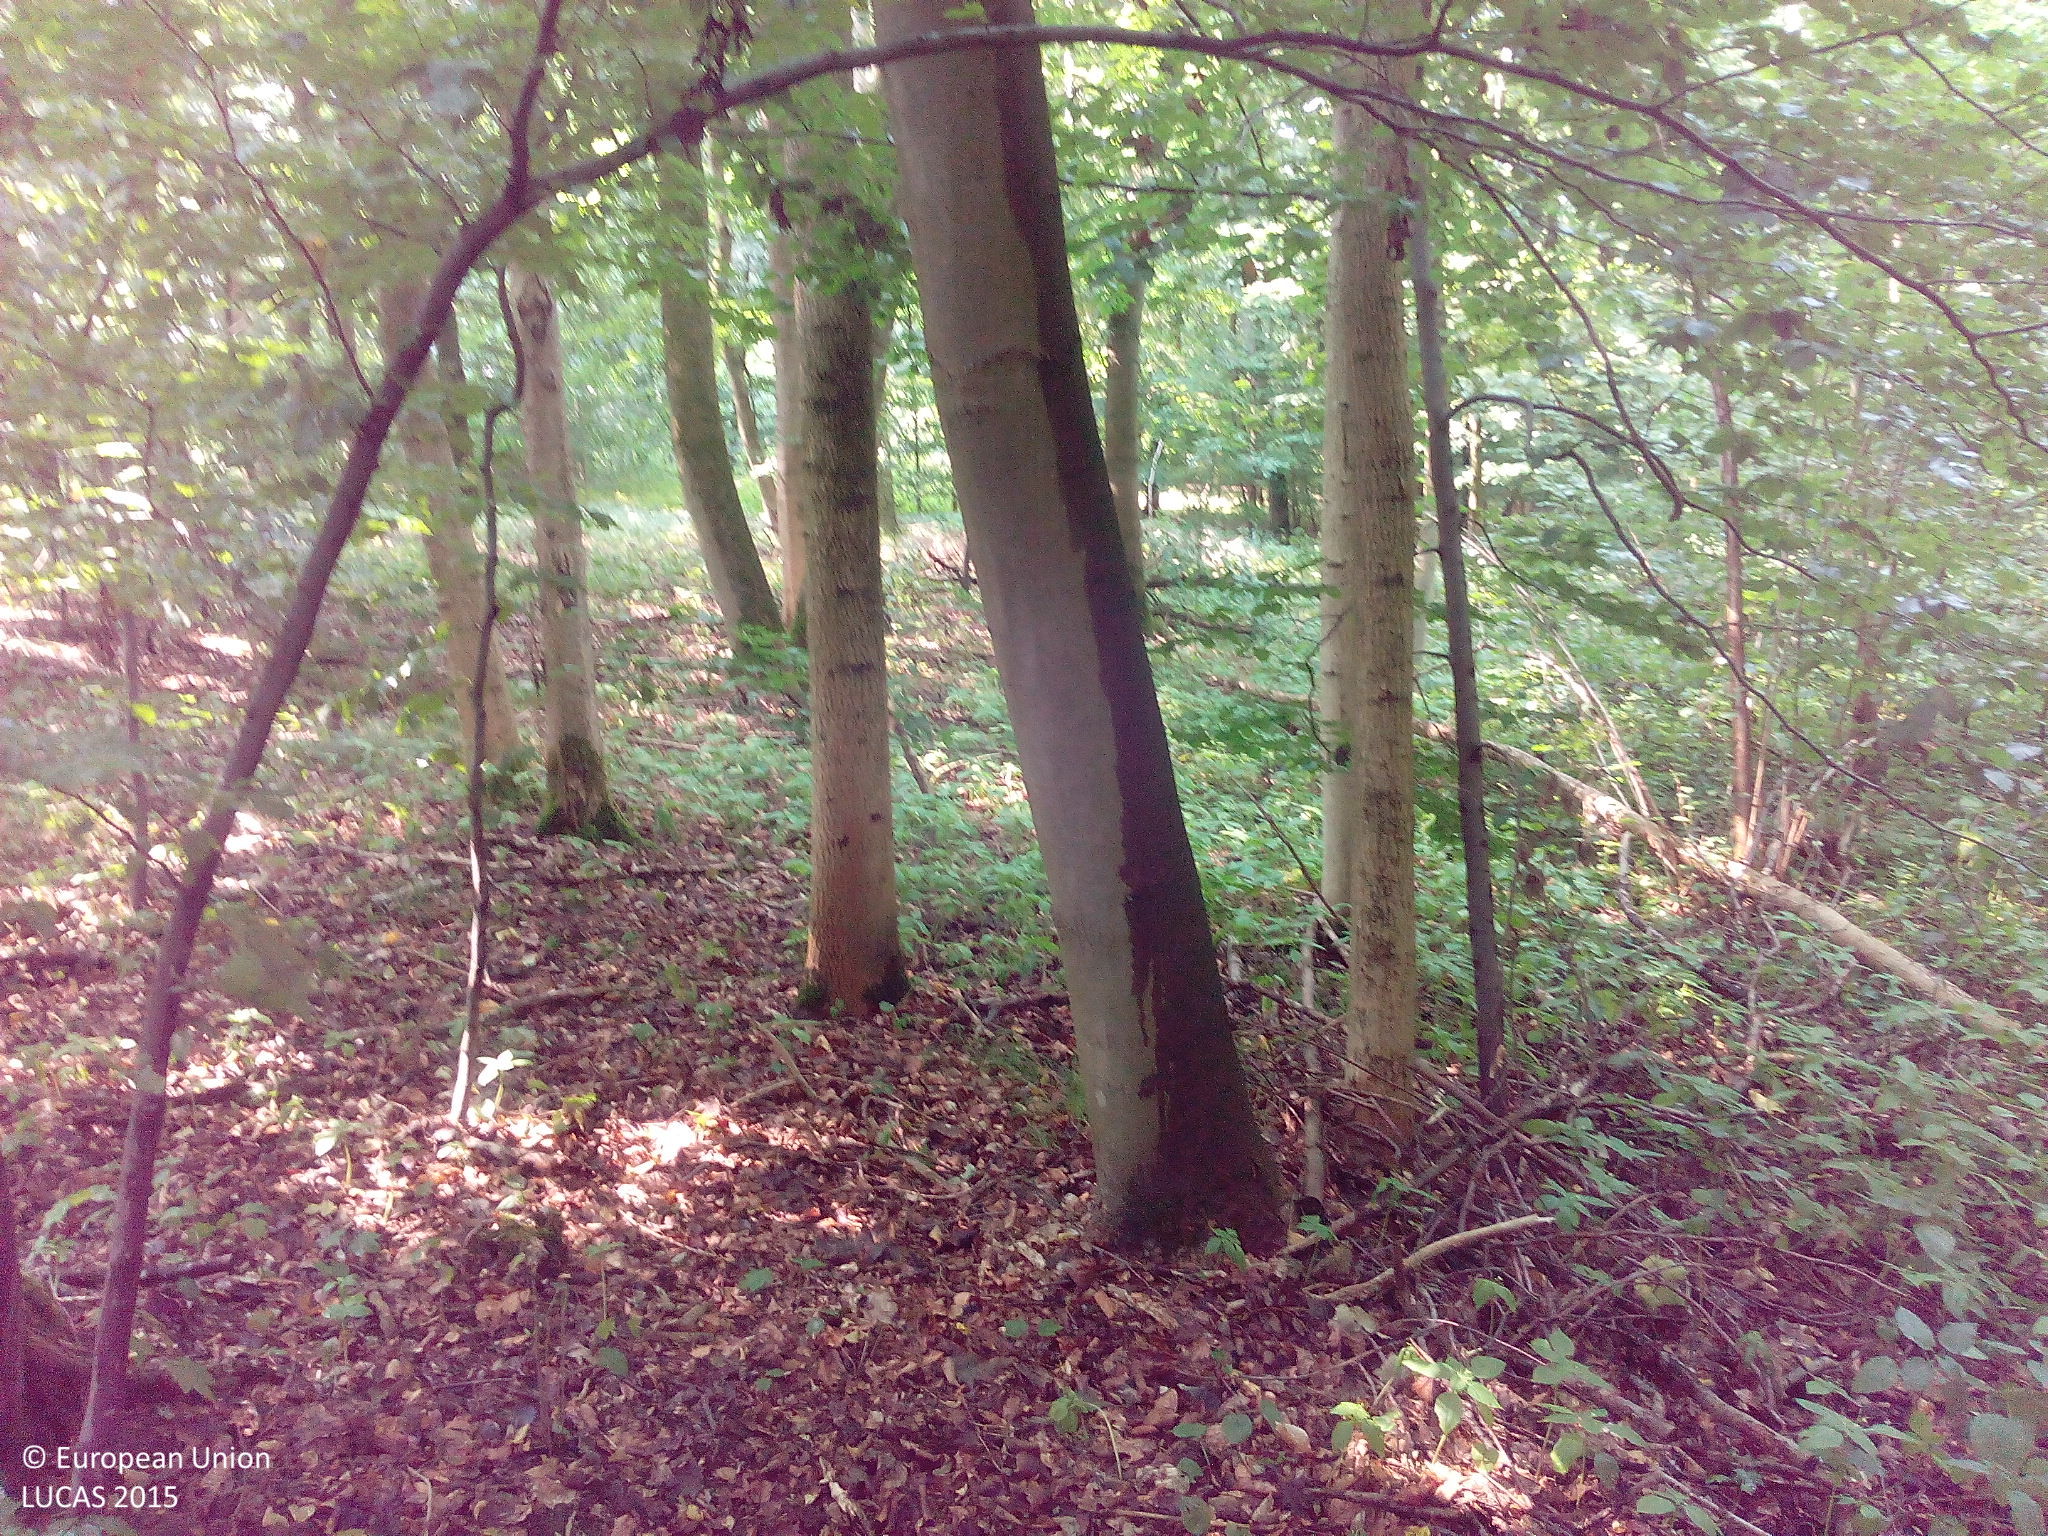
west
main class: Woodland
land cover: Broadleaved woodland
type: mesophytic deciduous forest
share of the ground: > 75 %
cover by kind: broadleaved forest trees 95 %, herbaceous plants 5 %
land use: Forestry
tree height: > 5 m
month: August
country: DE
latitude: 53.7938
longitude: 12.2915
